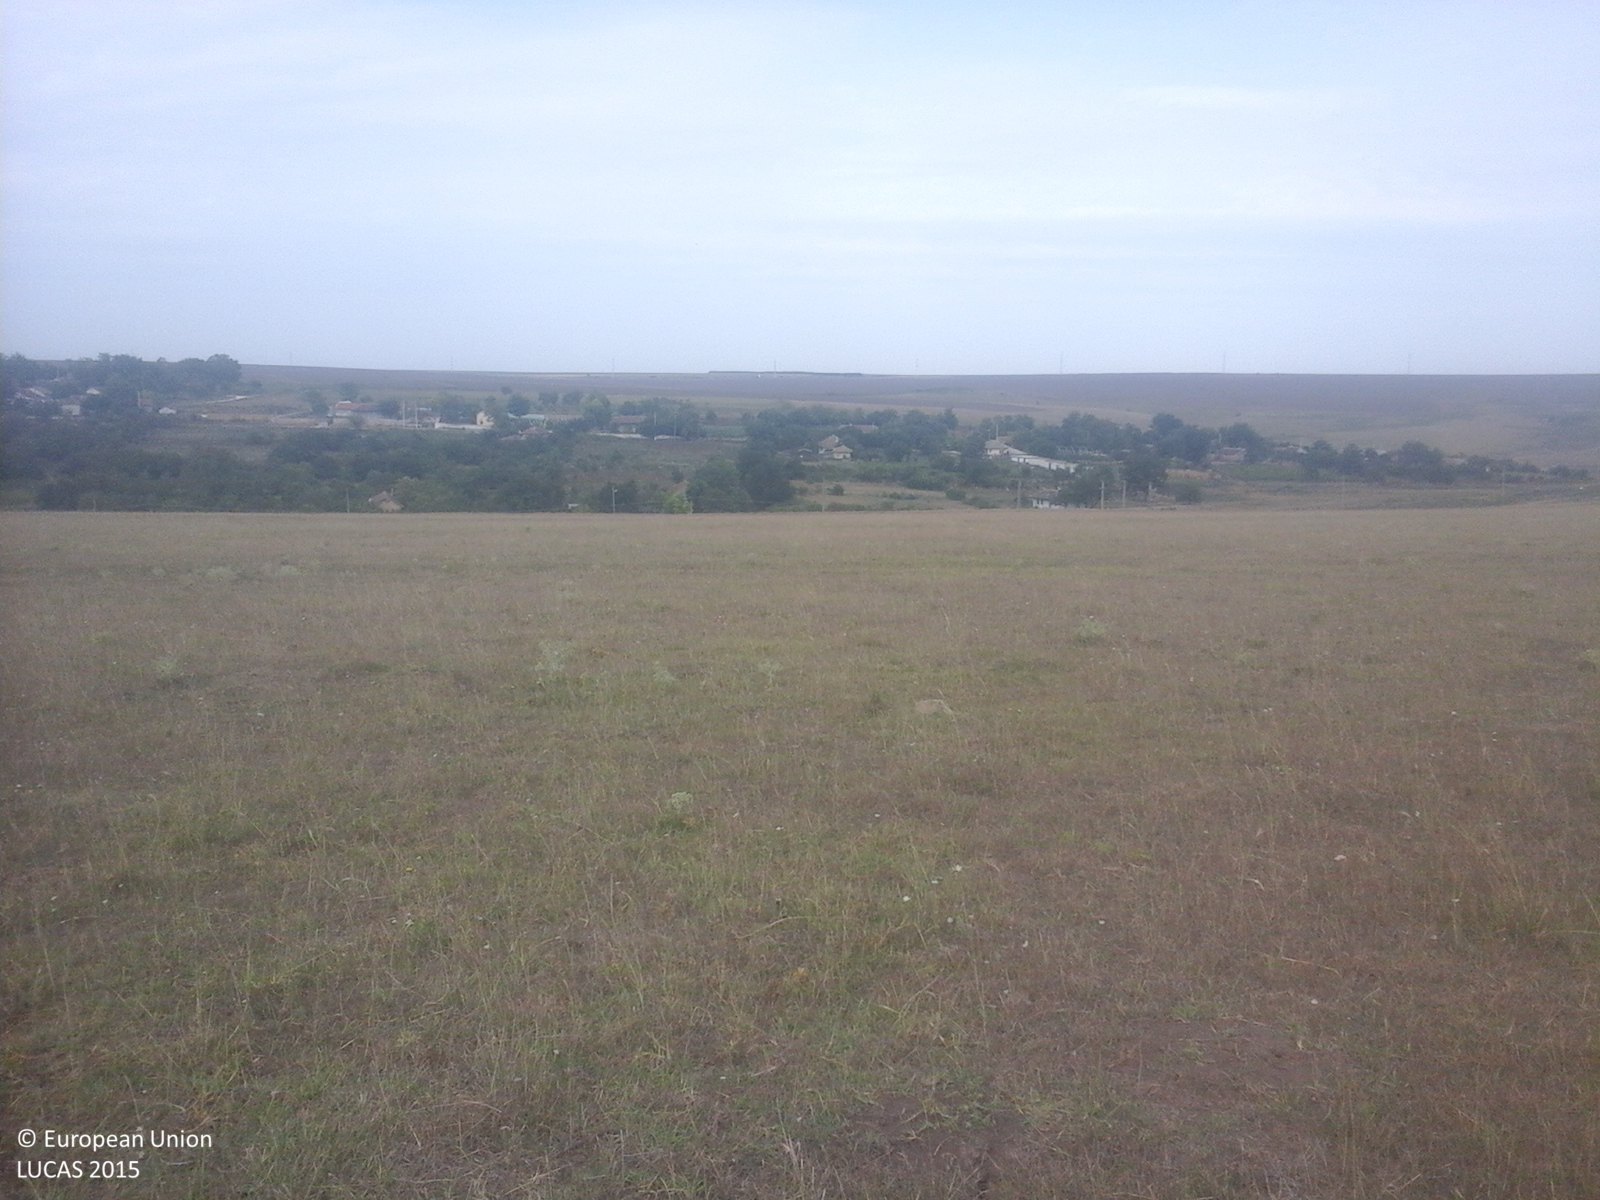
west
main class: Grassland
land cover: Grassland without tree/shrub cover
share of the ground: > 75 %
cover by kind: herbaceous plants 100 %
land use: Agriculture (excluding fallow land and kitchen gardens)
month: August
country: RO
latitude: 43.9710
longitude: 28.1426
